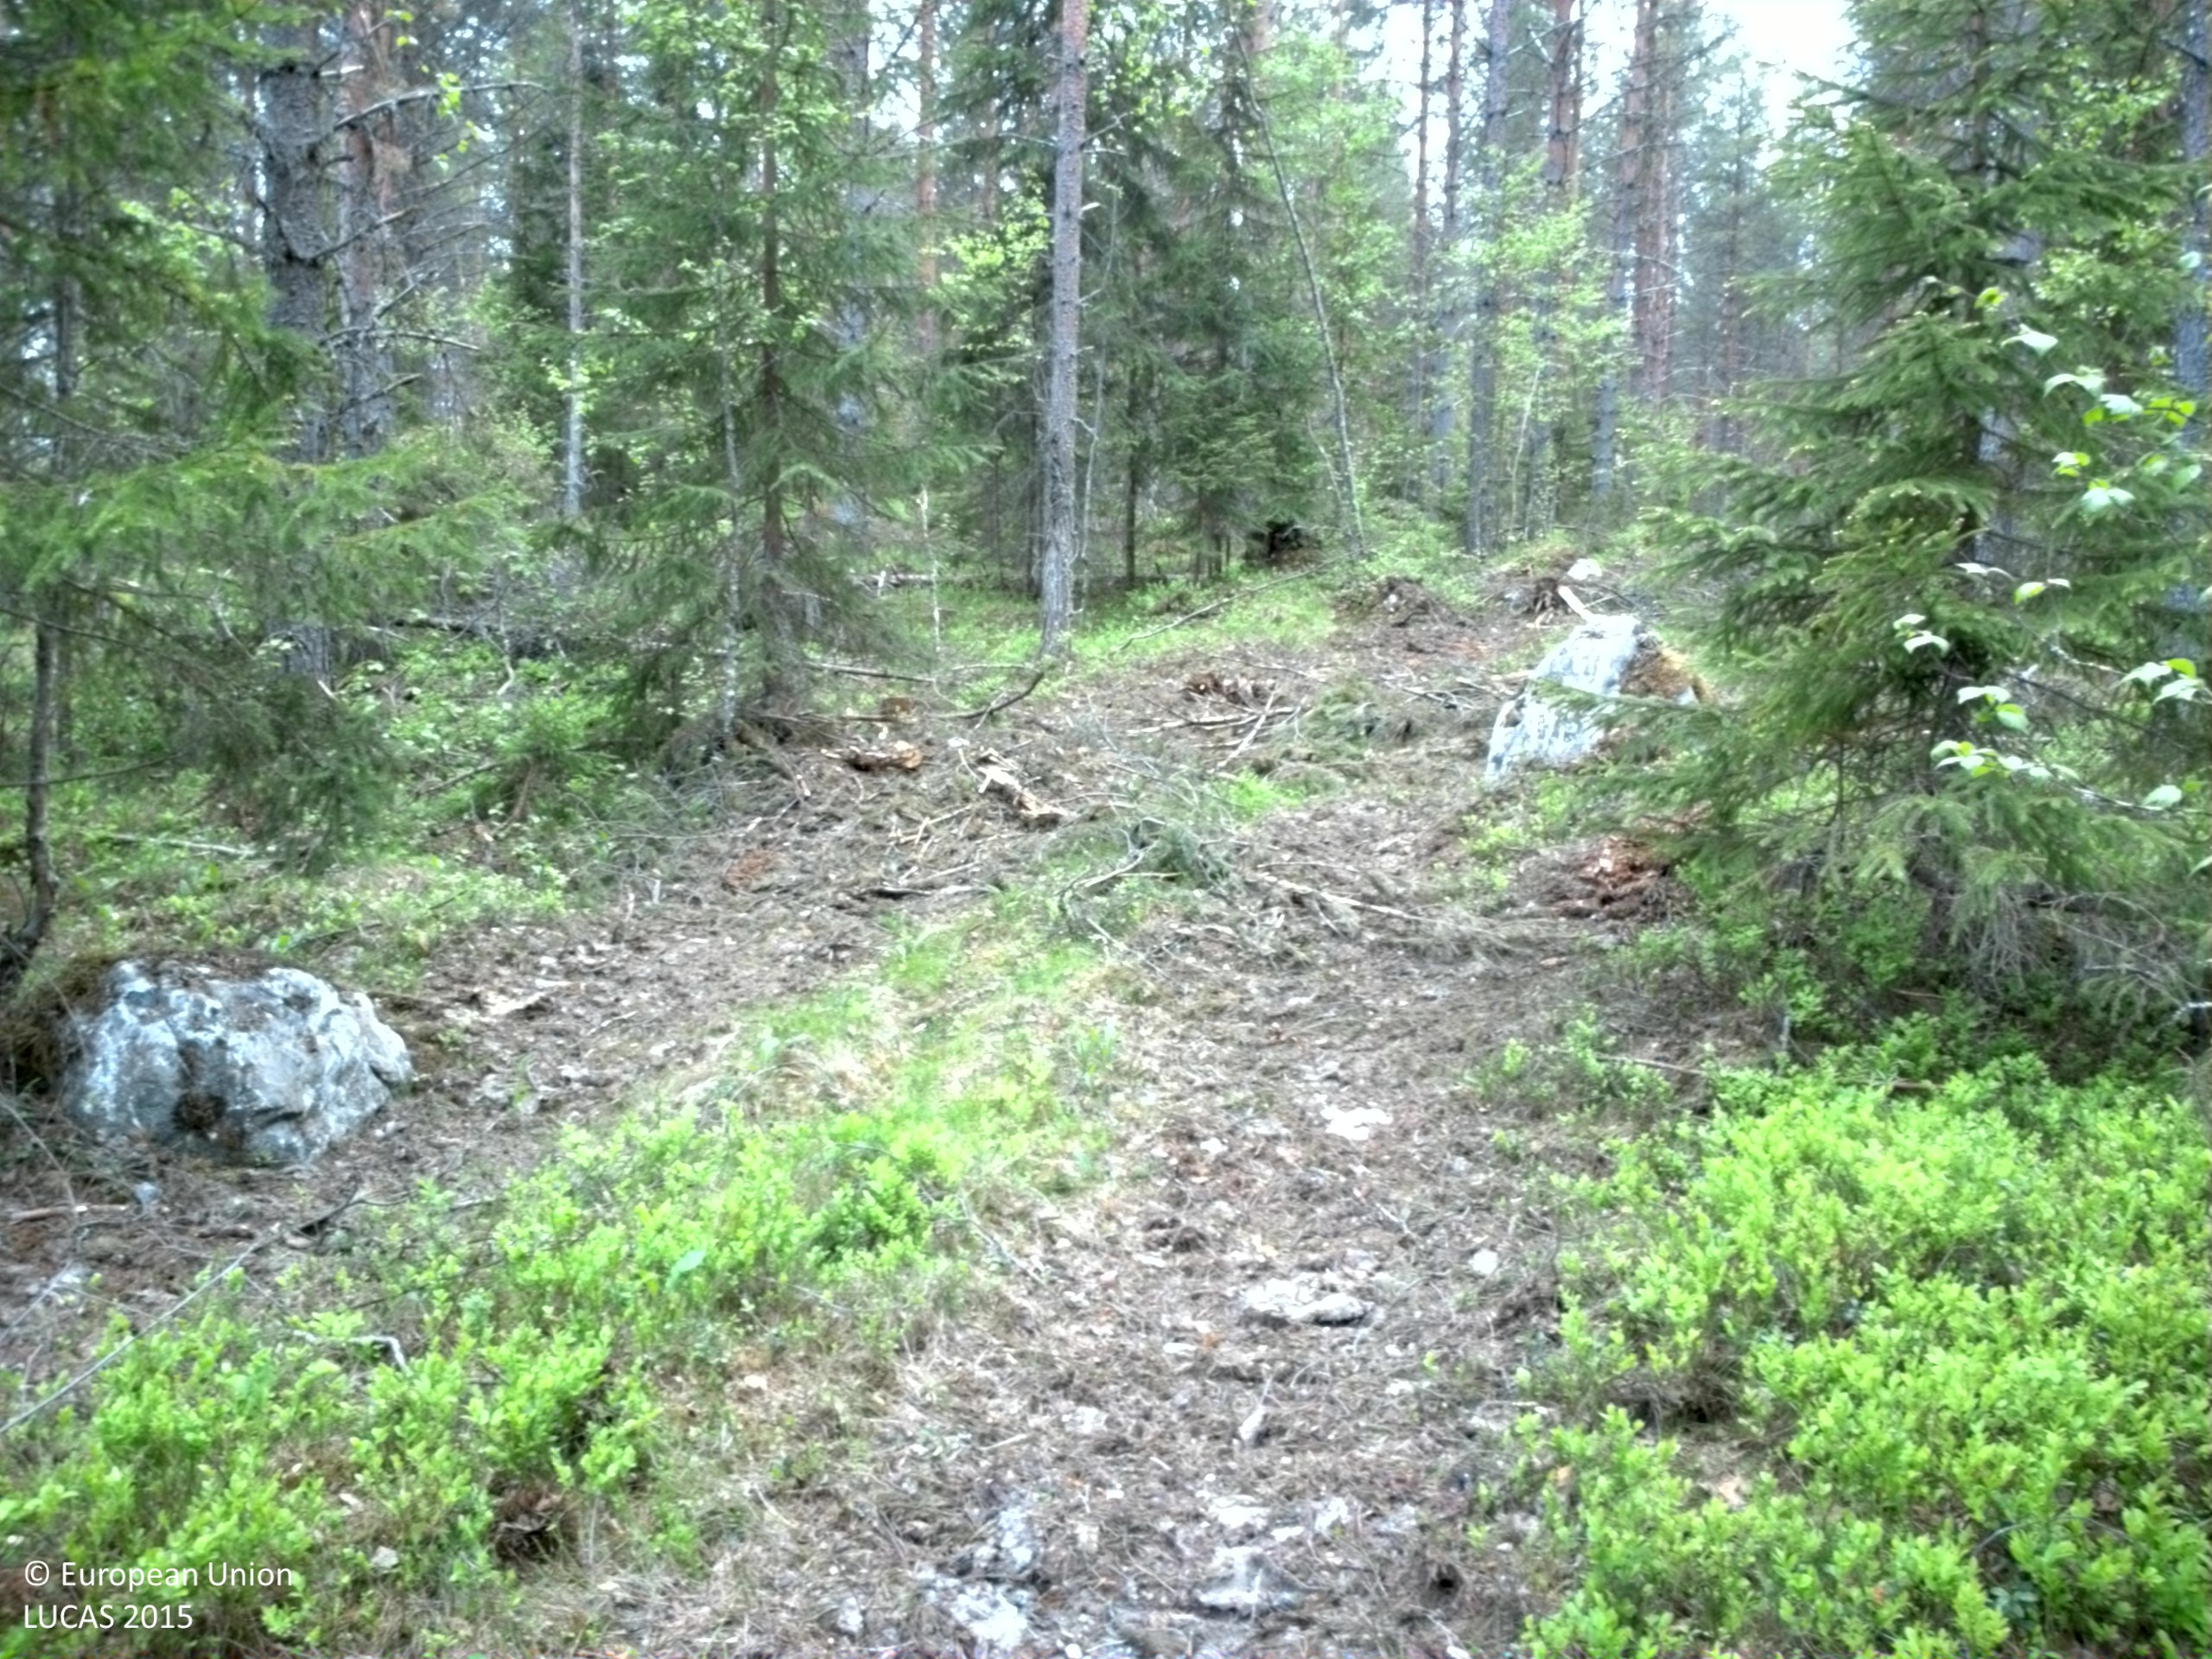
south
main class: Woodland
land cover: Pine dominated coniferous woodland
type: boreal forest
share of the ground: > 75 %
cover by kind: coniferous forest trees 90 %, shrubs 10 %
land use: Forestry
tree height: > 5 m
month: June
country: SE
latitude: 63.0402
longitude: 17.1533
